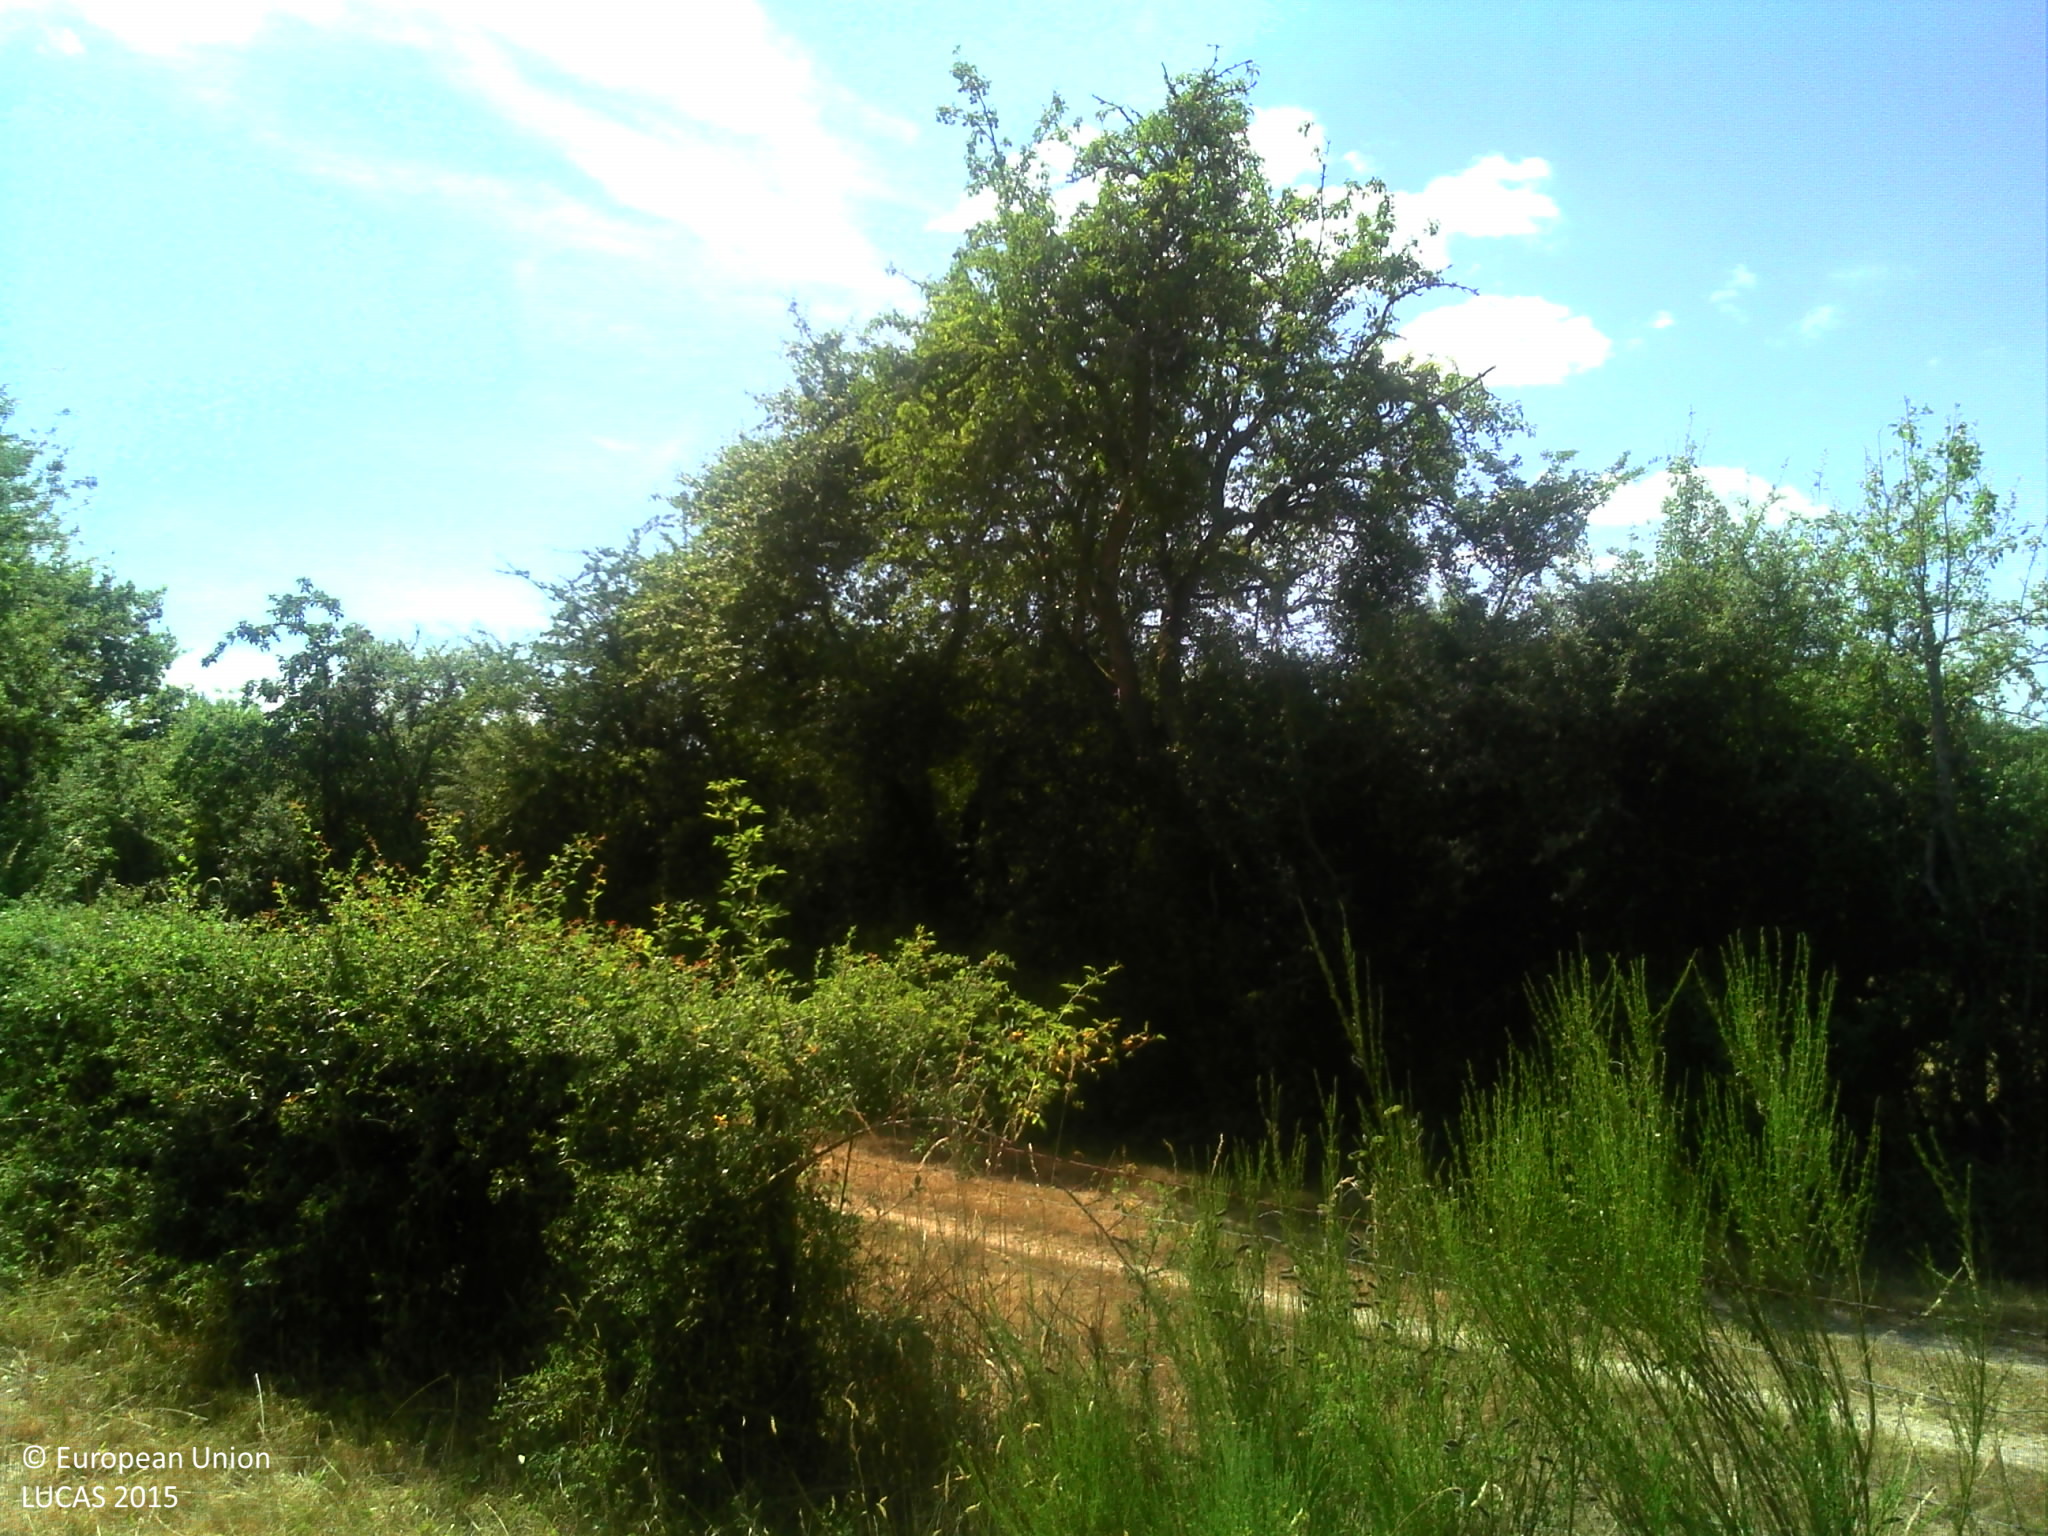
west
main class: Grassland
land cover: Grassland without tree/shrub cover
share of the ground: > 75 %
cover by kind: herbaceous plants 100 %
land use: Agriculture (excluding fallow land and kitchen gardens)
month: June
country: FR
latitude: 47.7713
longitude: 2.5321
